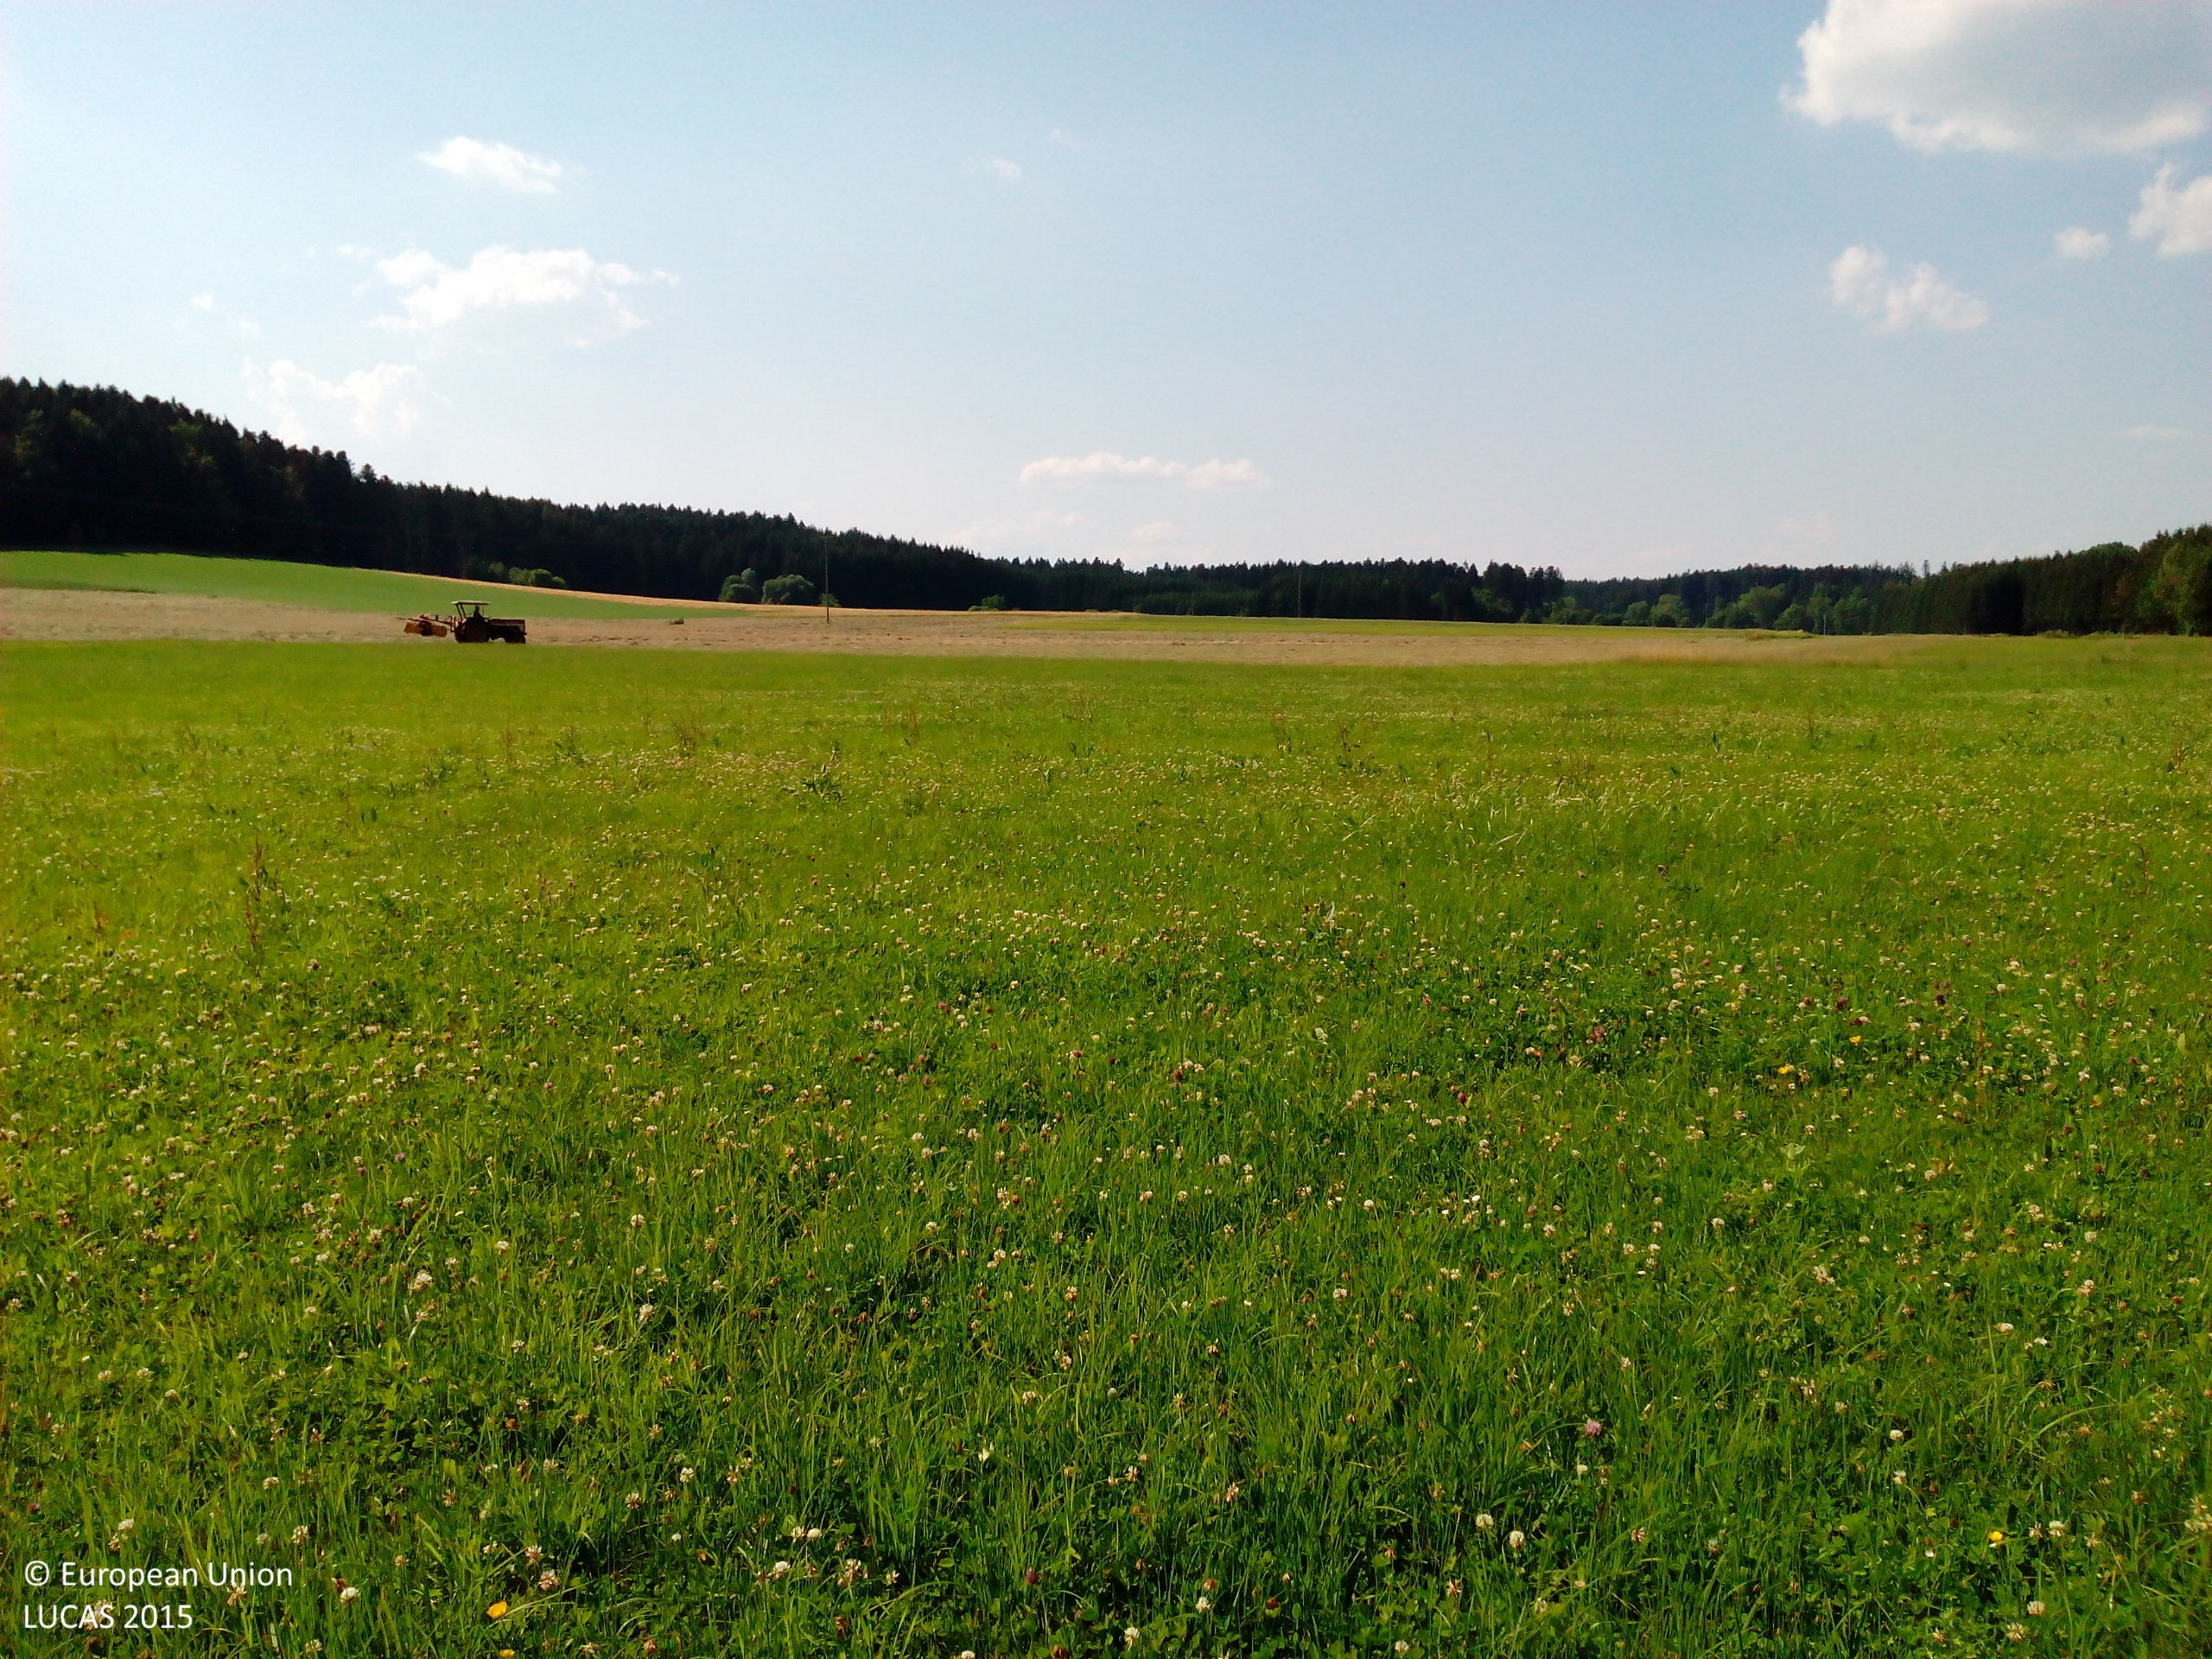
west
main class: Grassland
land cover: Grassland without tree/shrub cover
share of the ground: > 75 %
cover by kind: herbaceous plants 100 %
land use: Agriculture (excluding fallow land and kitchen gardens)
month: July
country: DE
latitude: 48.0539
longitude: 8.6994
